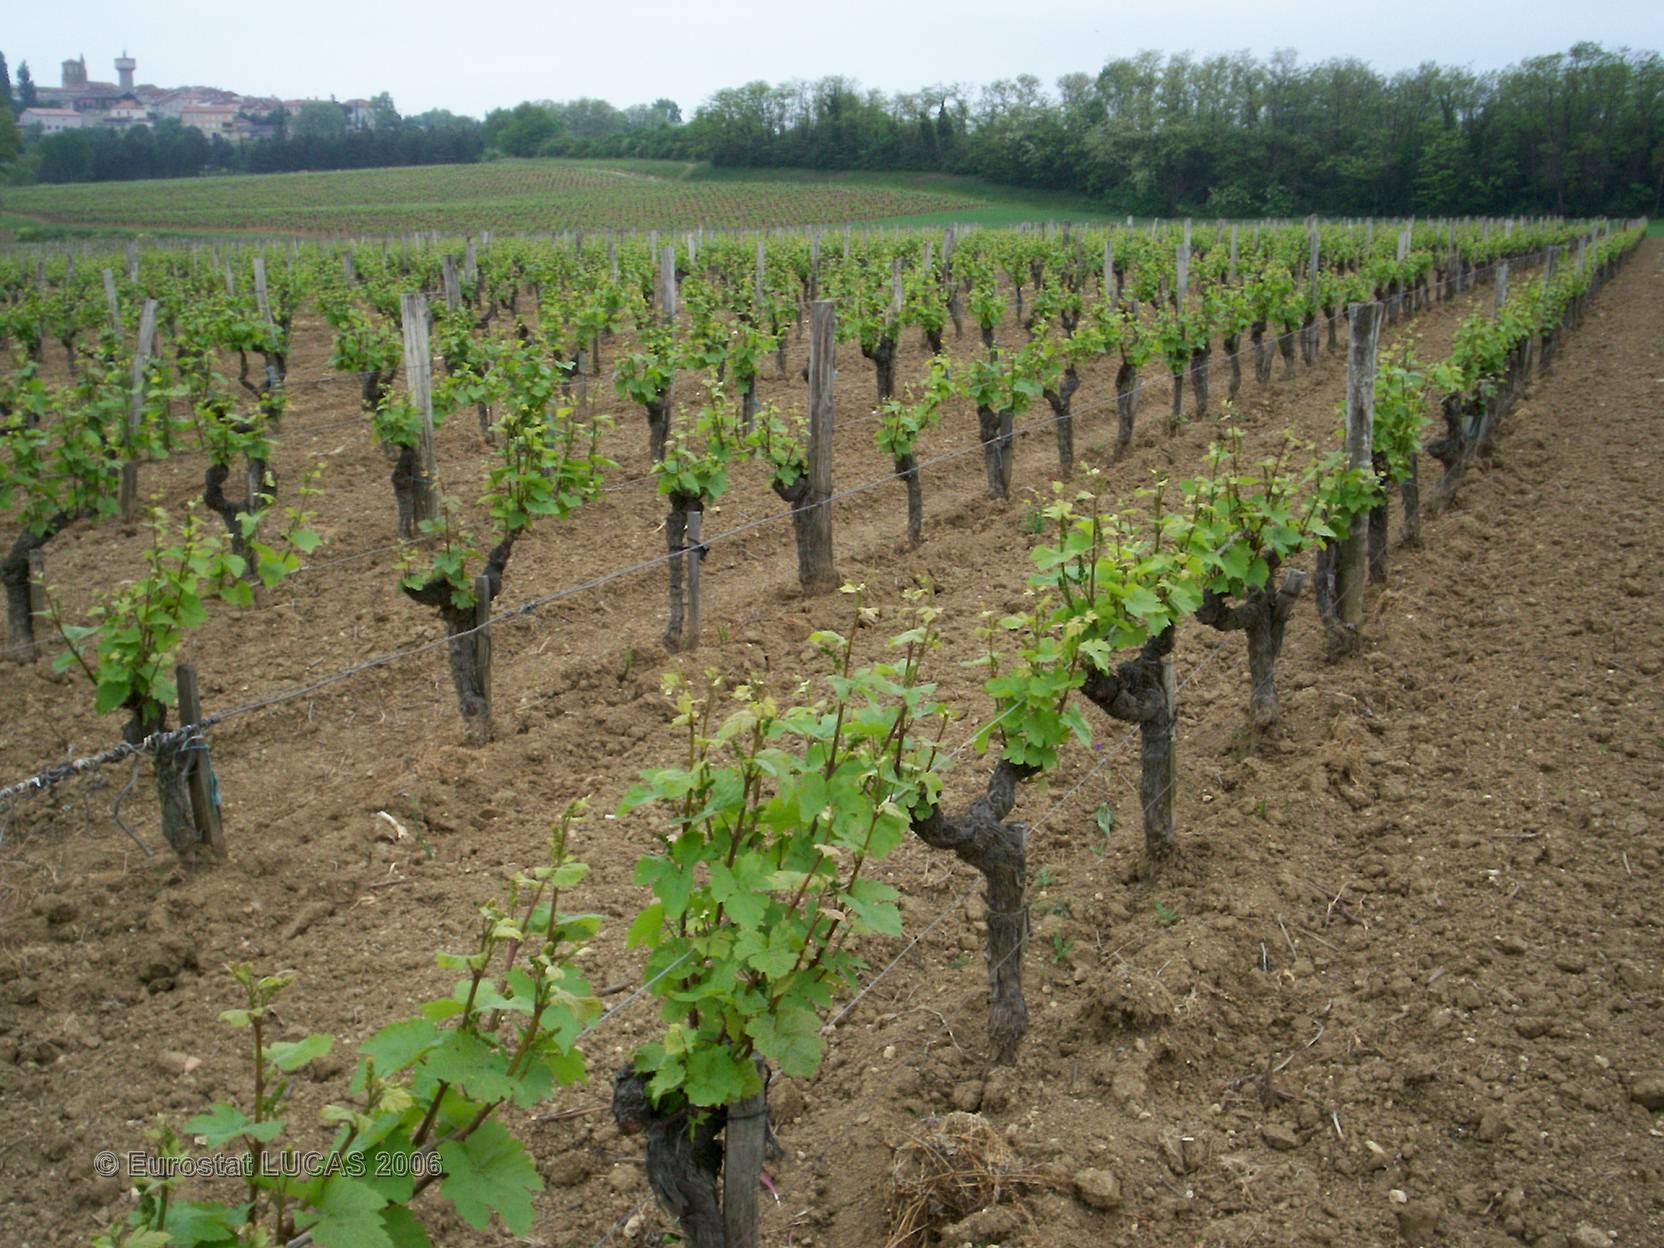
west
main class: Cropland
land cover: Vineyards
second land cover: Bare land
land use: Agriculture (excluding fallow land and kitchen gardens)
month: May
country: FR
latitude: 43.8901
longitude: 0.2472
